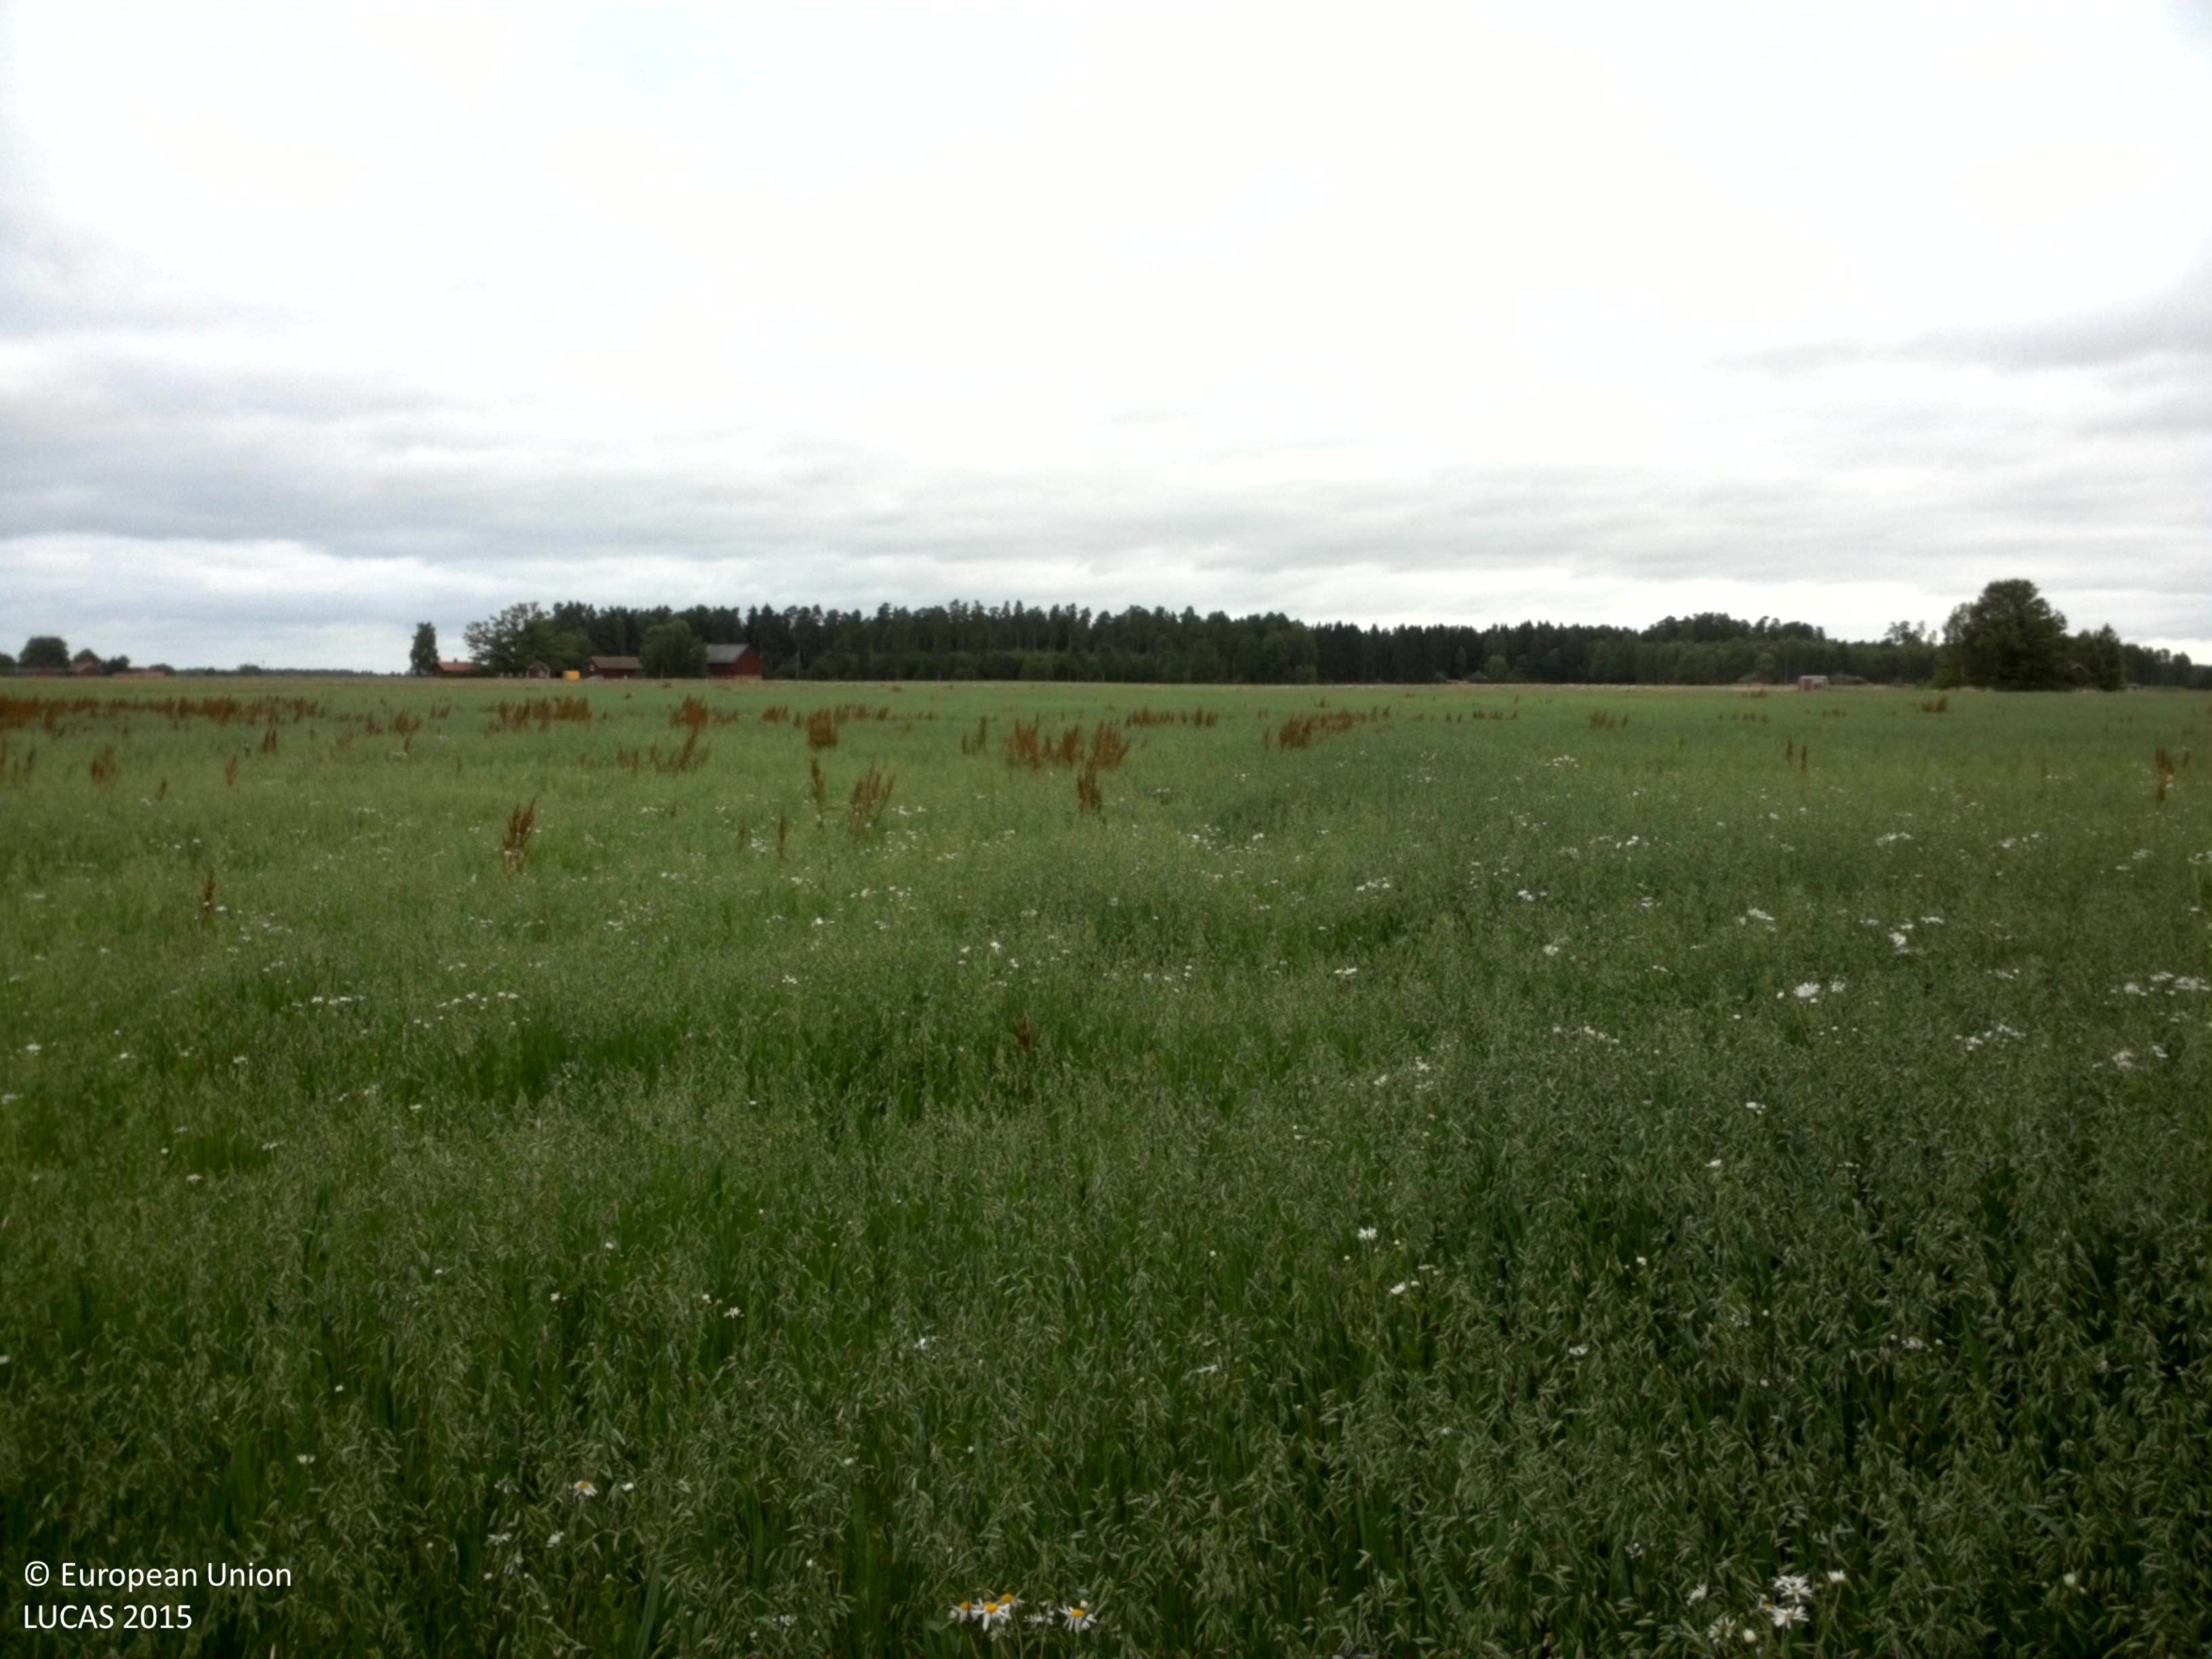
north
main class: Cropland
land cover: Oats
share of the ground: > 75 %
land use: Agriculture (excluding fallow land and kitchen gardens)
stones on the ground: 10 - 25 %
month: July
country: SE
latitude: 58.4482
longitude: 13.3352
